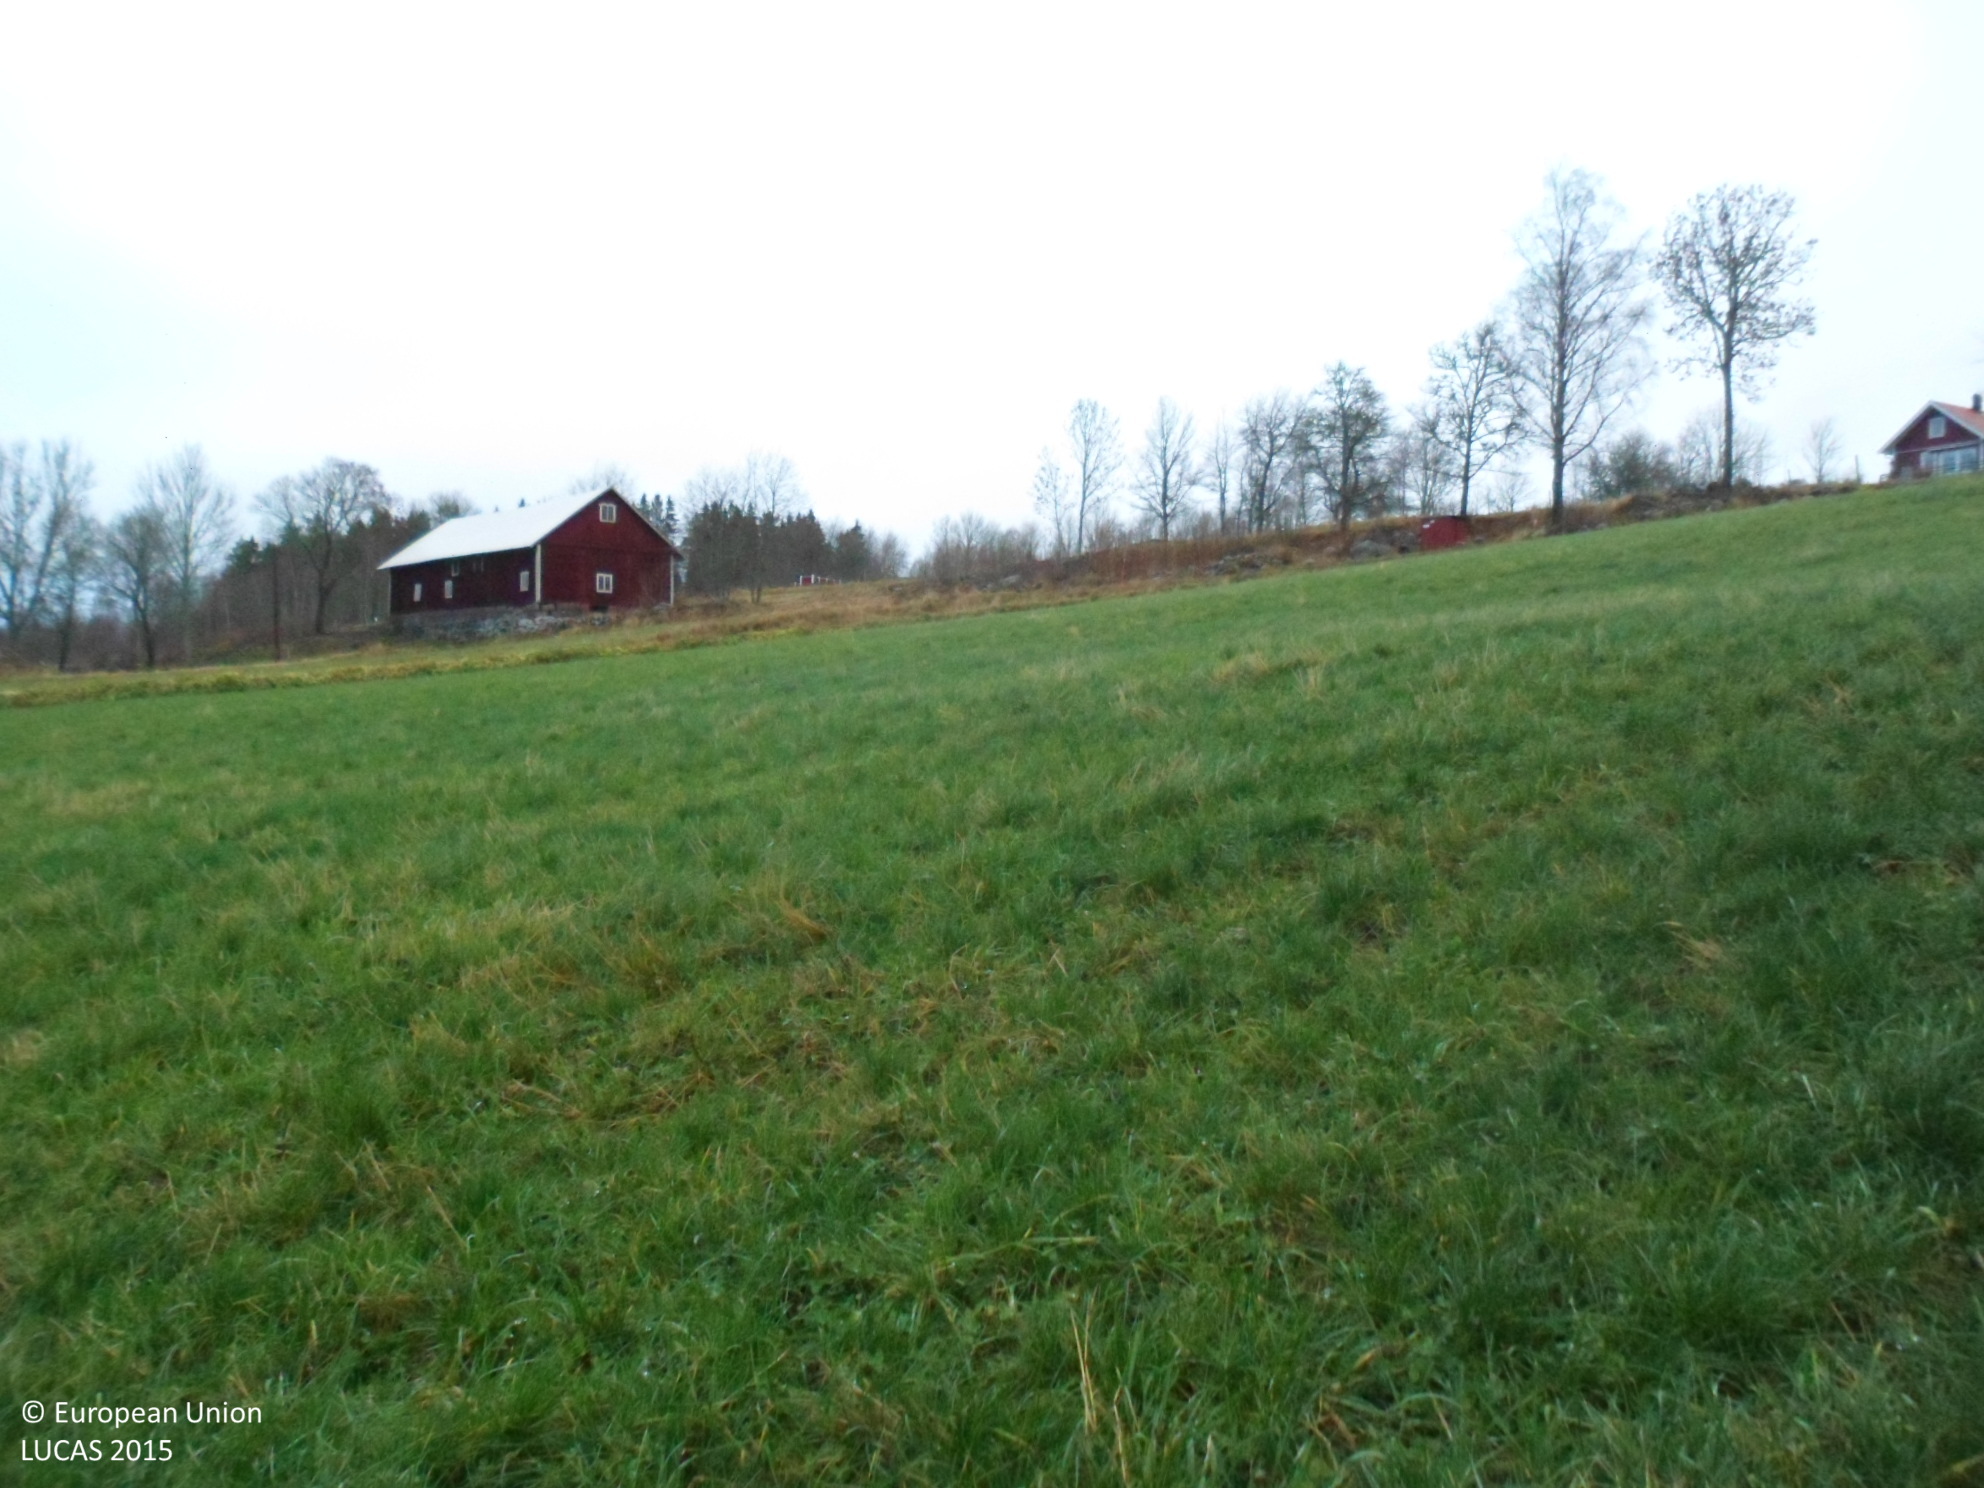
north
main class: Grassland
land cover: Grassland without tree/shrub cover
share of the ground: > 75 %
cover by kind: herbaceous plants 100 %
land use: Agriculture (excluding fallow land and kitchen gardens)
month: November
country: SE
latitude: 57.9783
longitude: 14.6109
